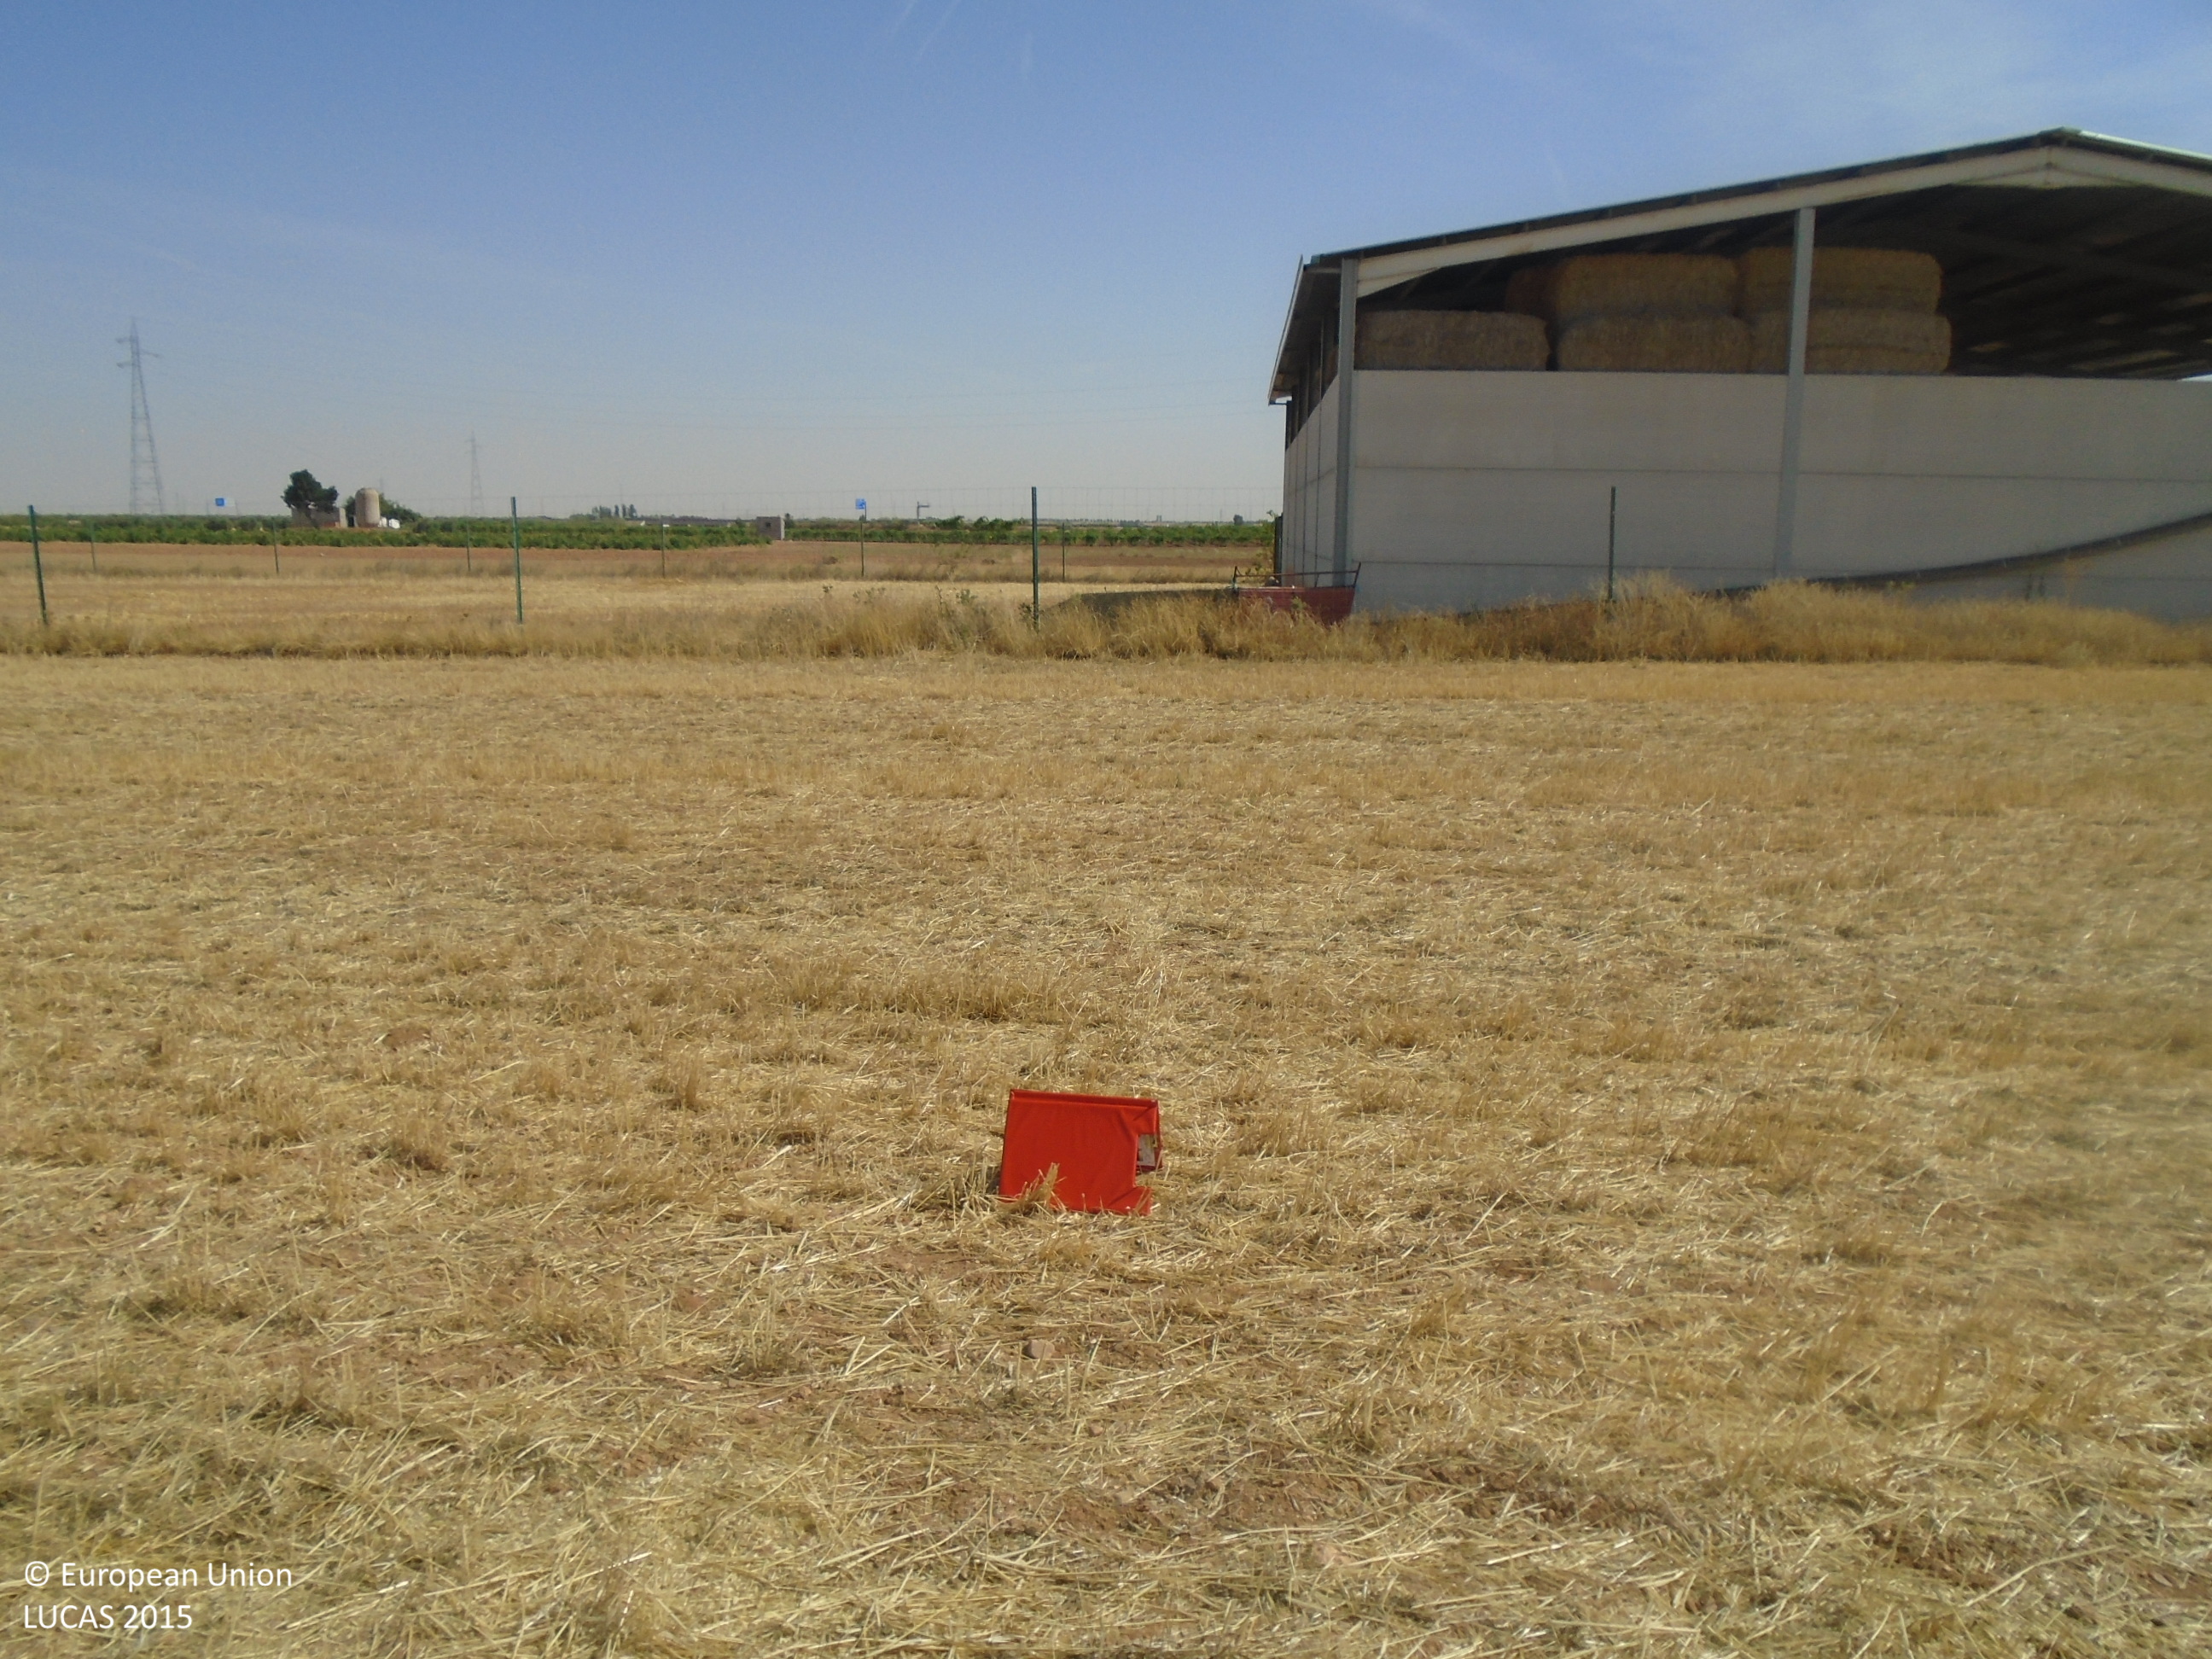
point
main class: Cropland
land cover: Oats
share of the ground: > 75 %
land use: Agriculture (excluding fallow land and kitchen gardens)
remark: Harvested field
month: July
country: ES
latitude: 39.4493
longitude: -3.5606
